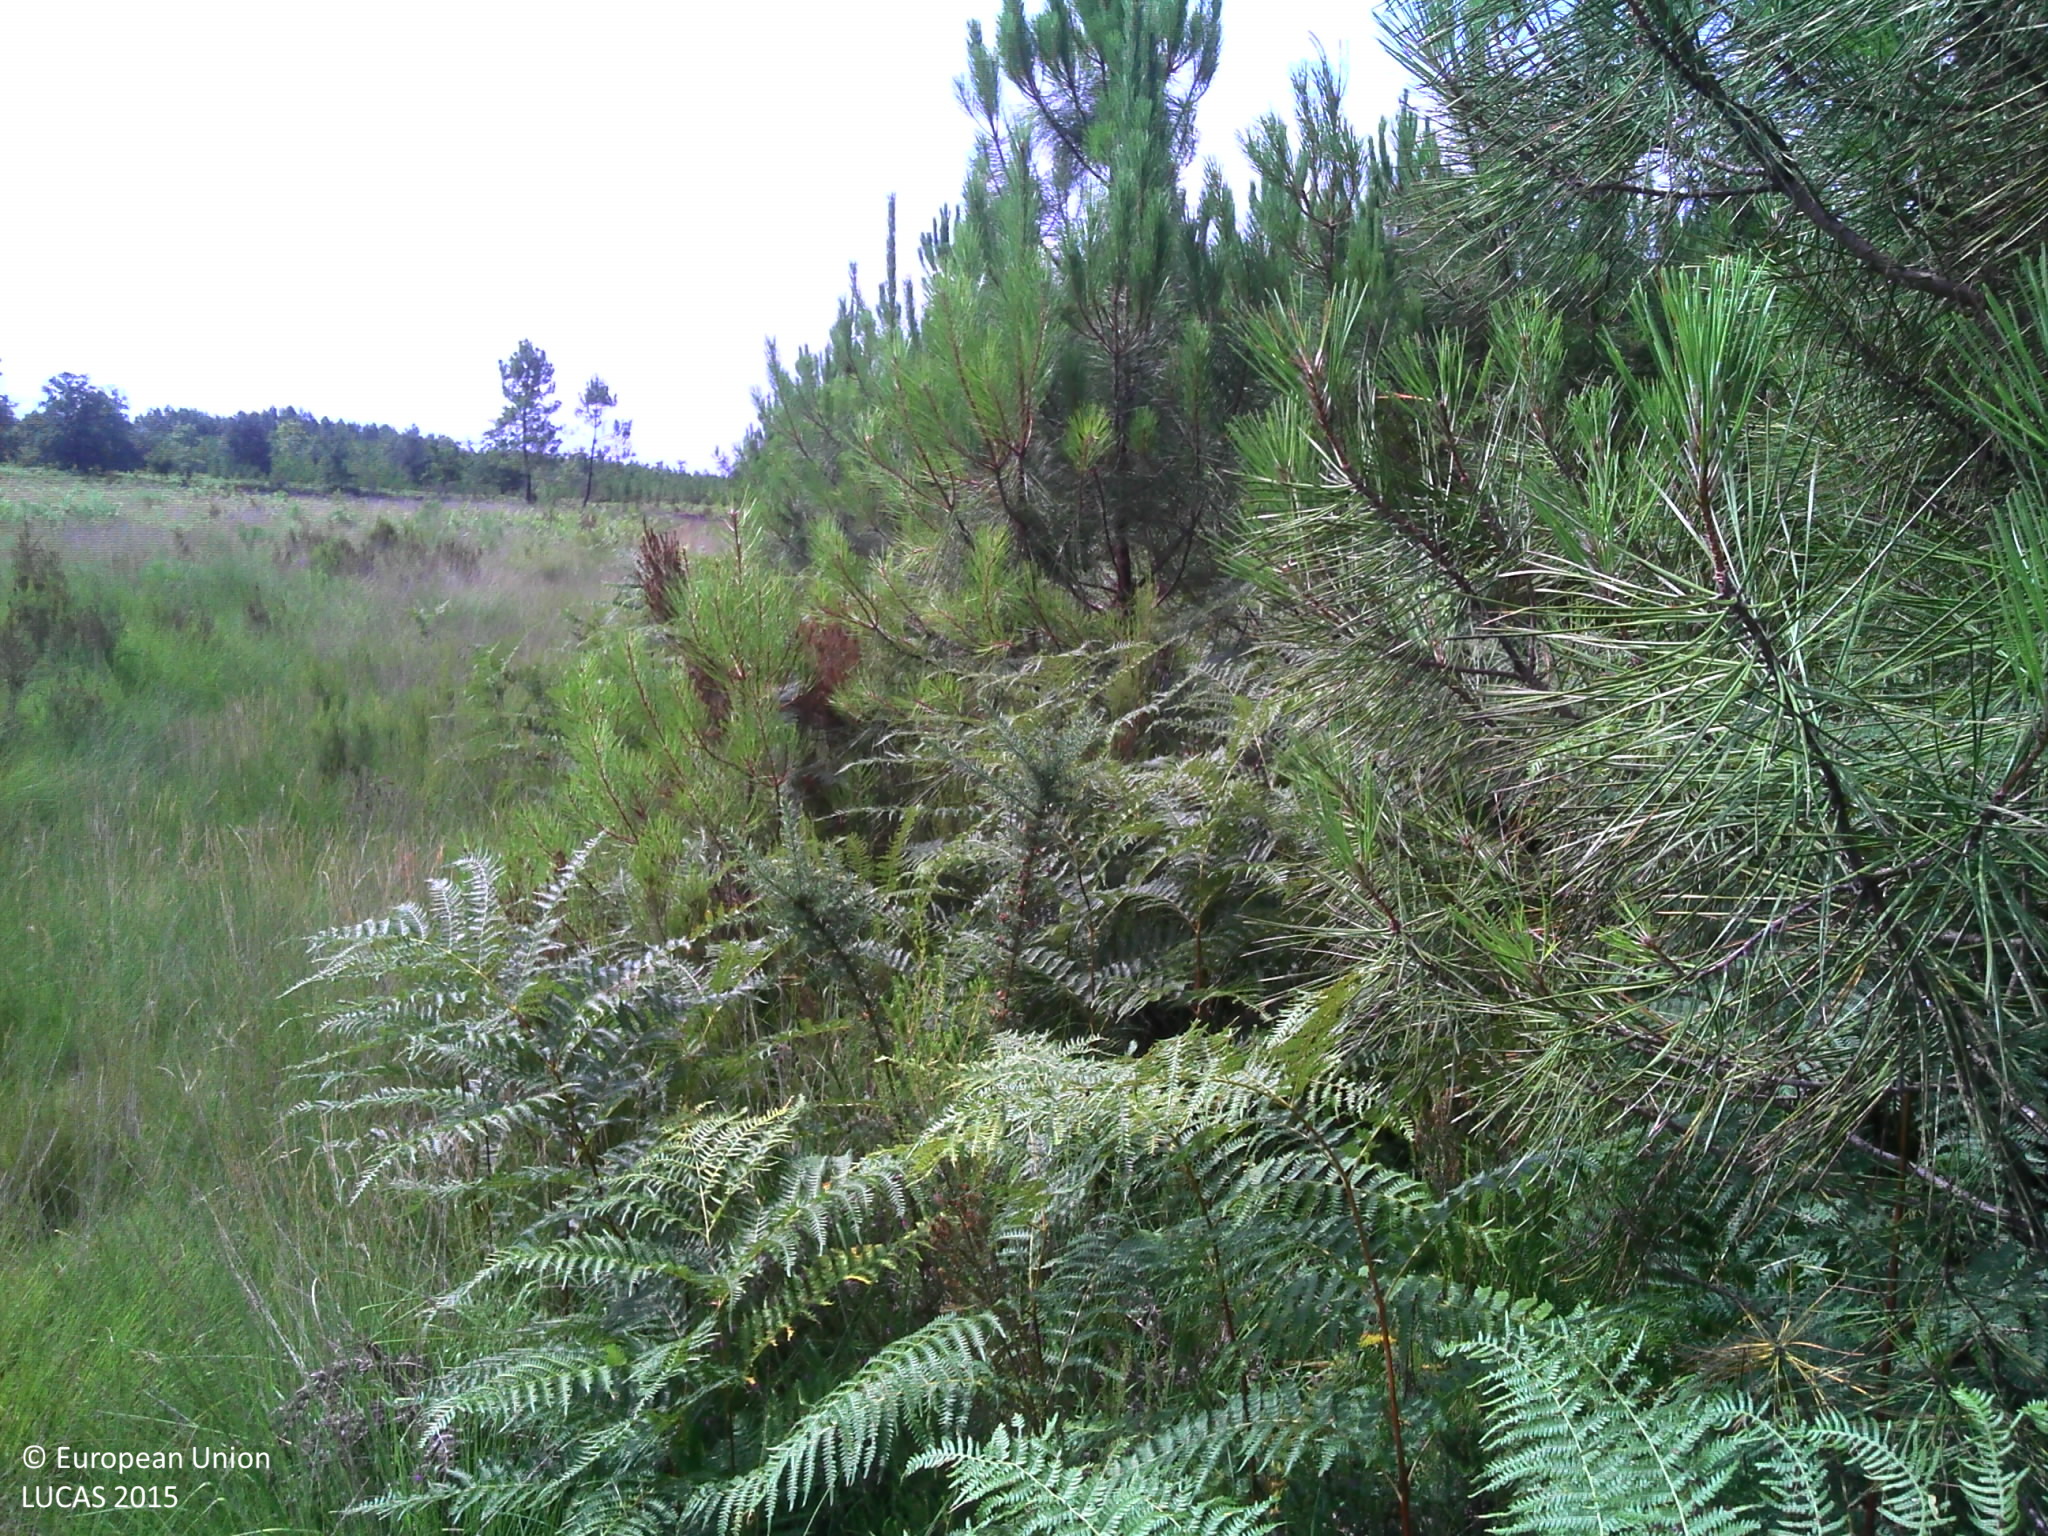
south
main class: Woodland
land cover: Pine dominated coniferous woodland
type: coniferous forest of the mediterranean region
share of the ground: 50 - 75 %
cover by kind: coniferous forest trees 60 %, herbaceous plants 40 %
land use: Forestry
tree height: < 5 m
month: July
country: FR
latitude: 44.1842
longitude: -0.6357
